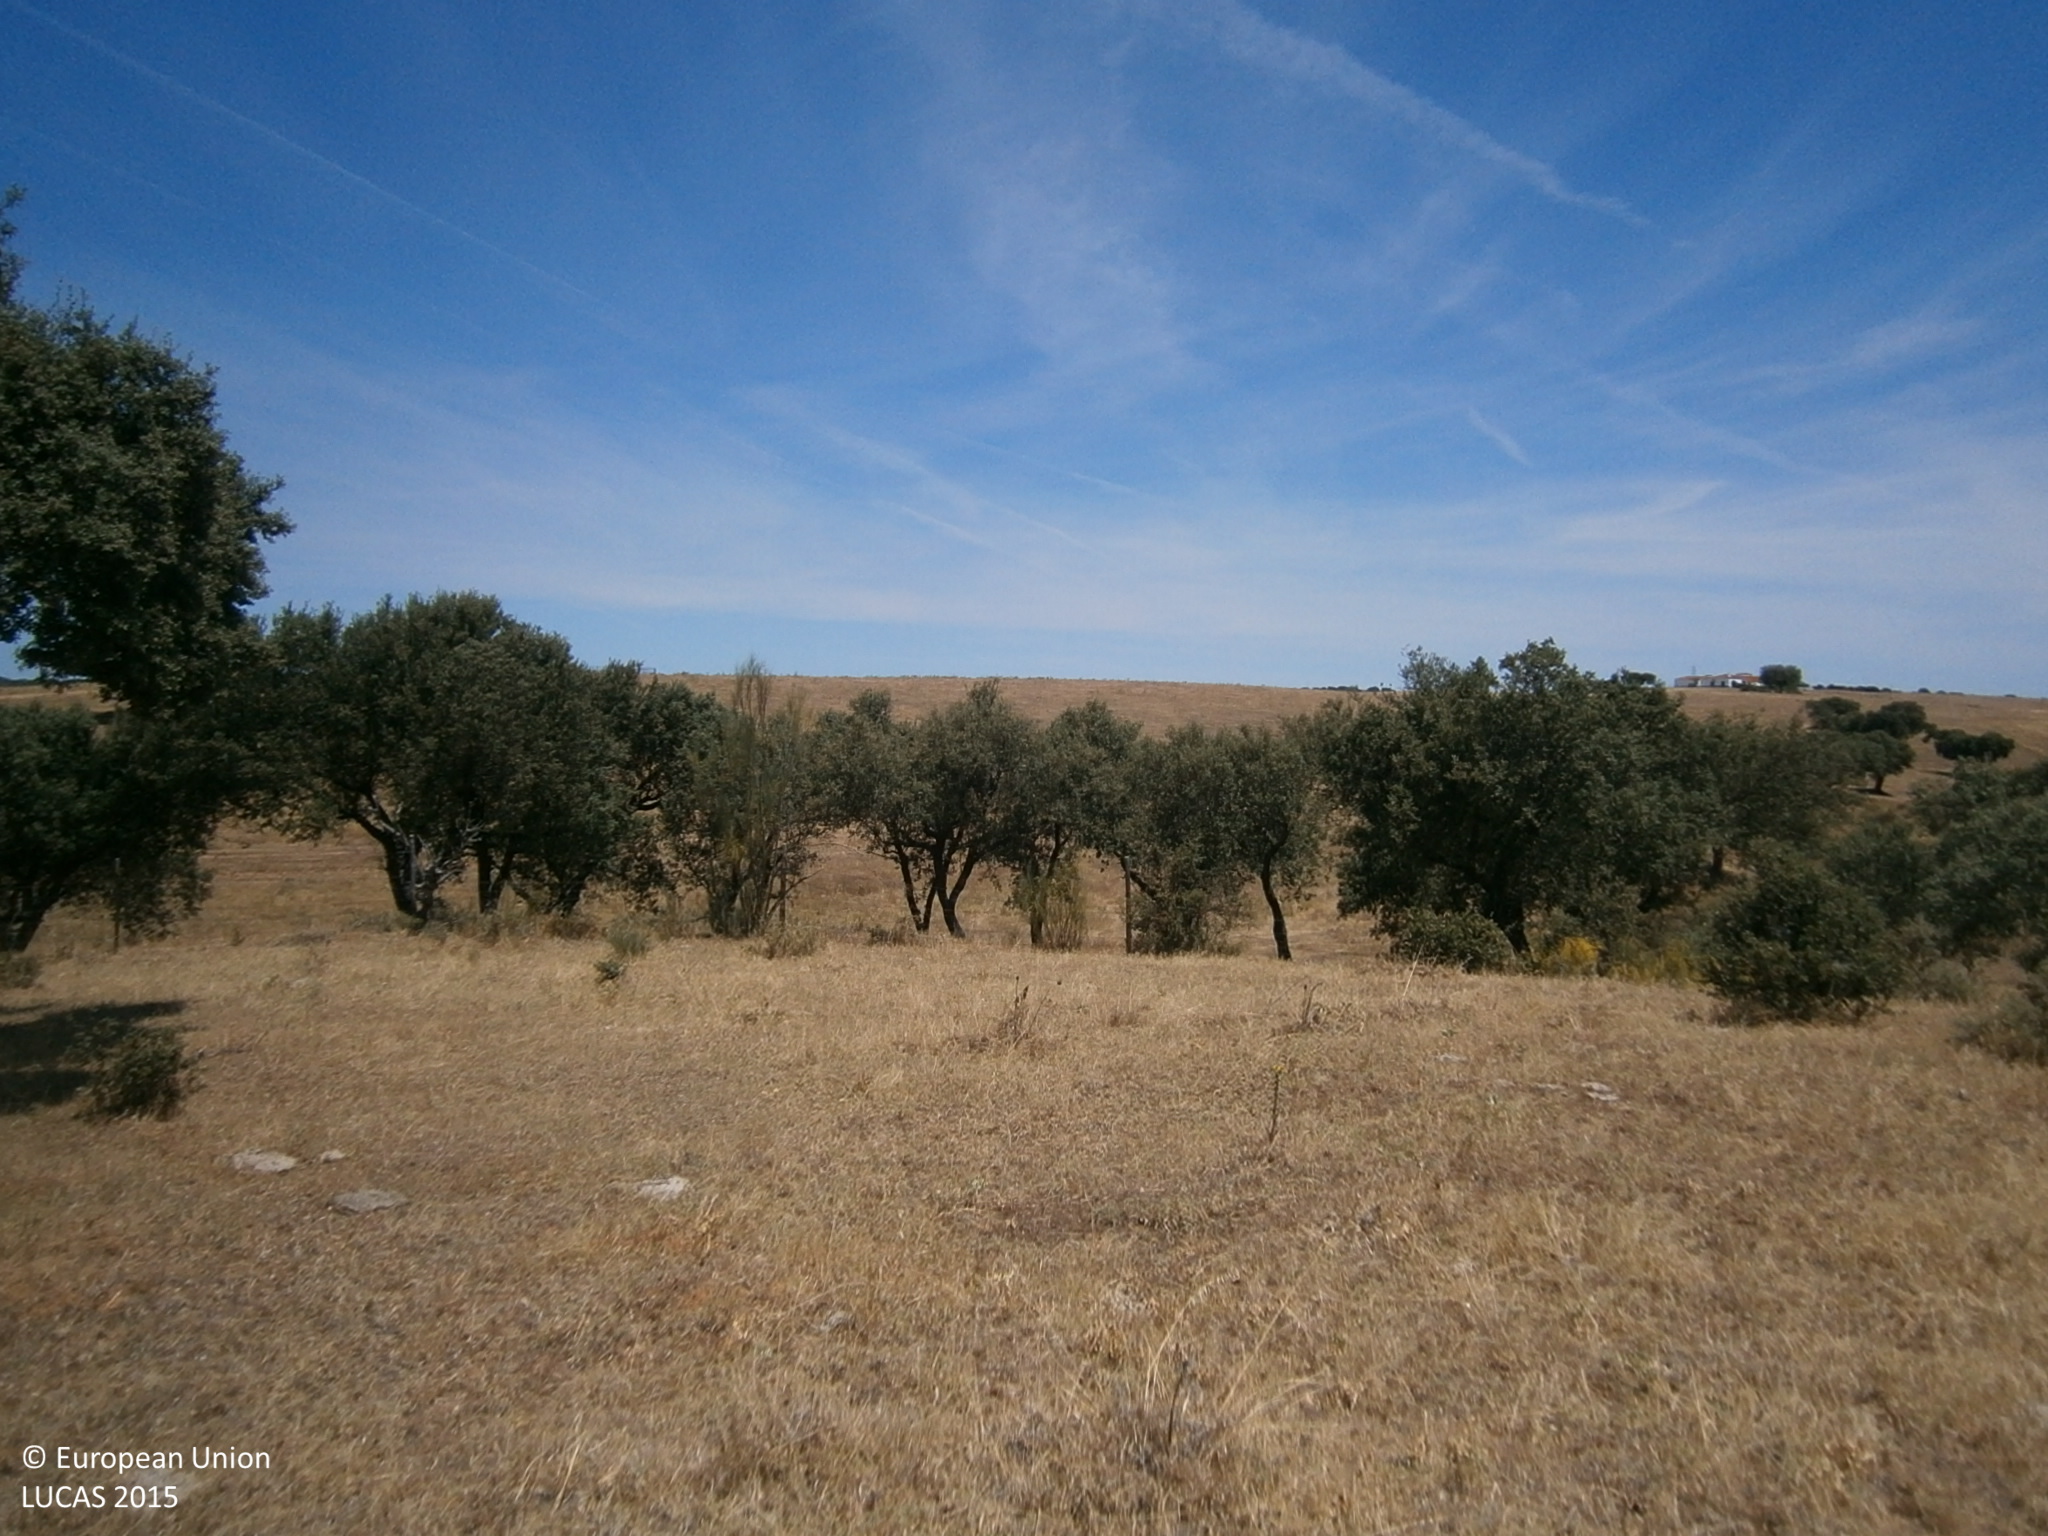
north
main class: Grassland
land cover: Grassland with sparse tree/shrub cover
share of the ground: > 75 %
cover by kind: herbaceous plants 90 %, broadleaved forest trees 5 %, shrubs 5 %
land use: Agriculture (excluding fallow land and kitchen gardens)
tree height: > 5 m
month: July
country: ES
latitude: 38.6430
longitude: -7.2008
